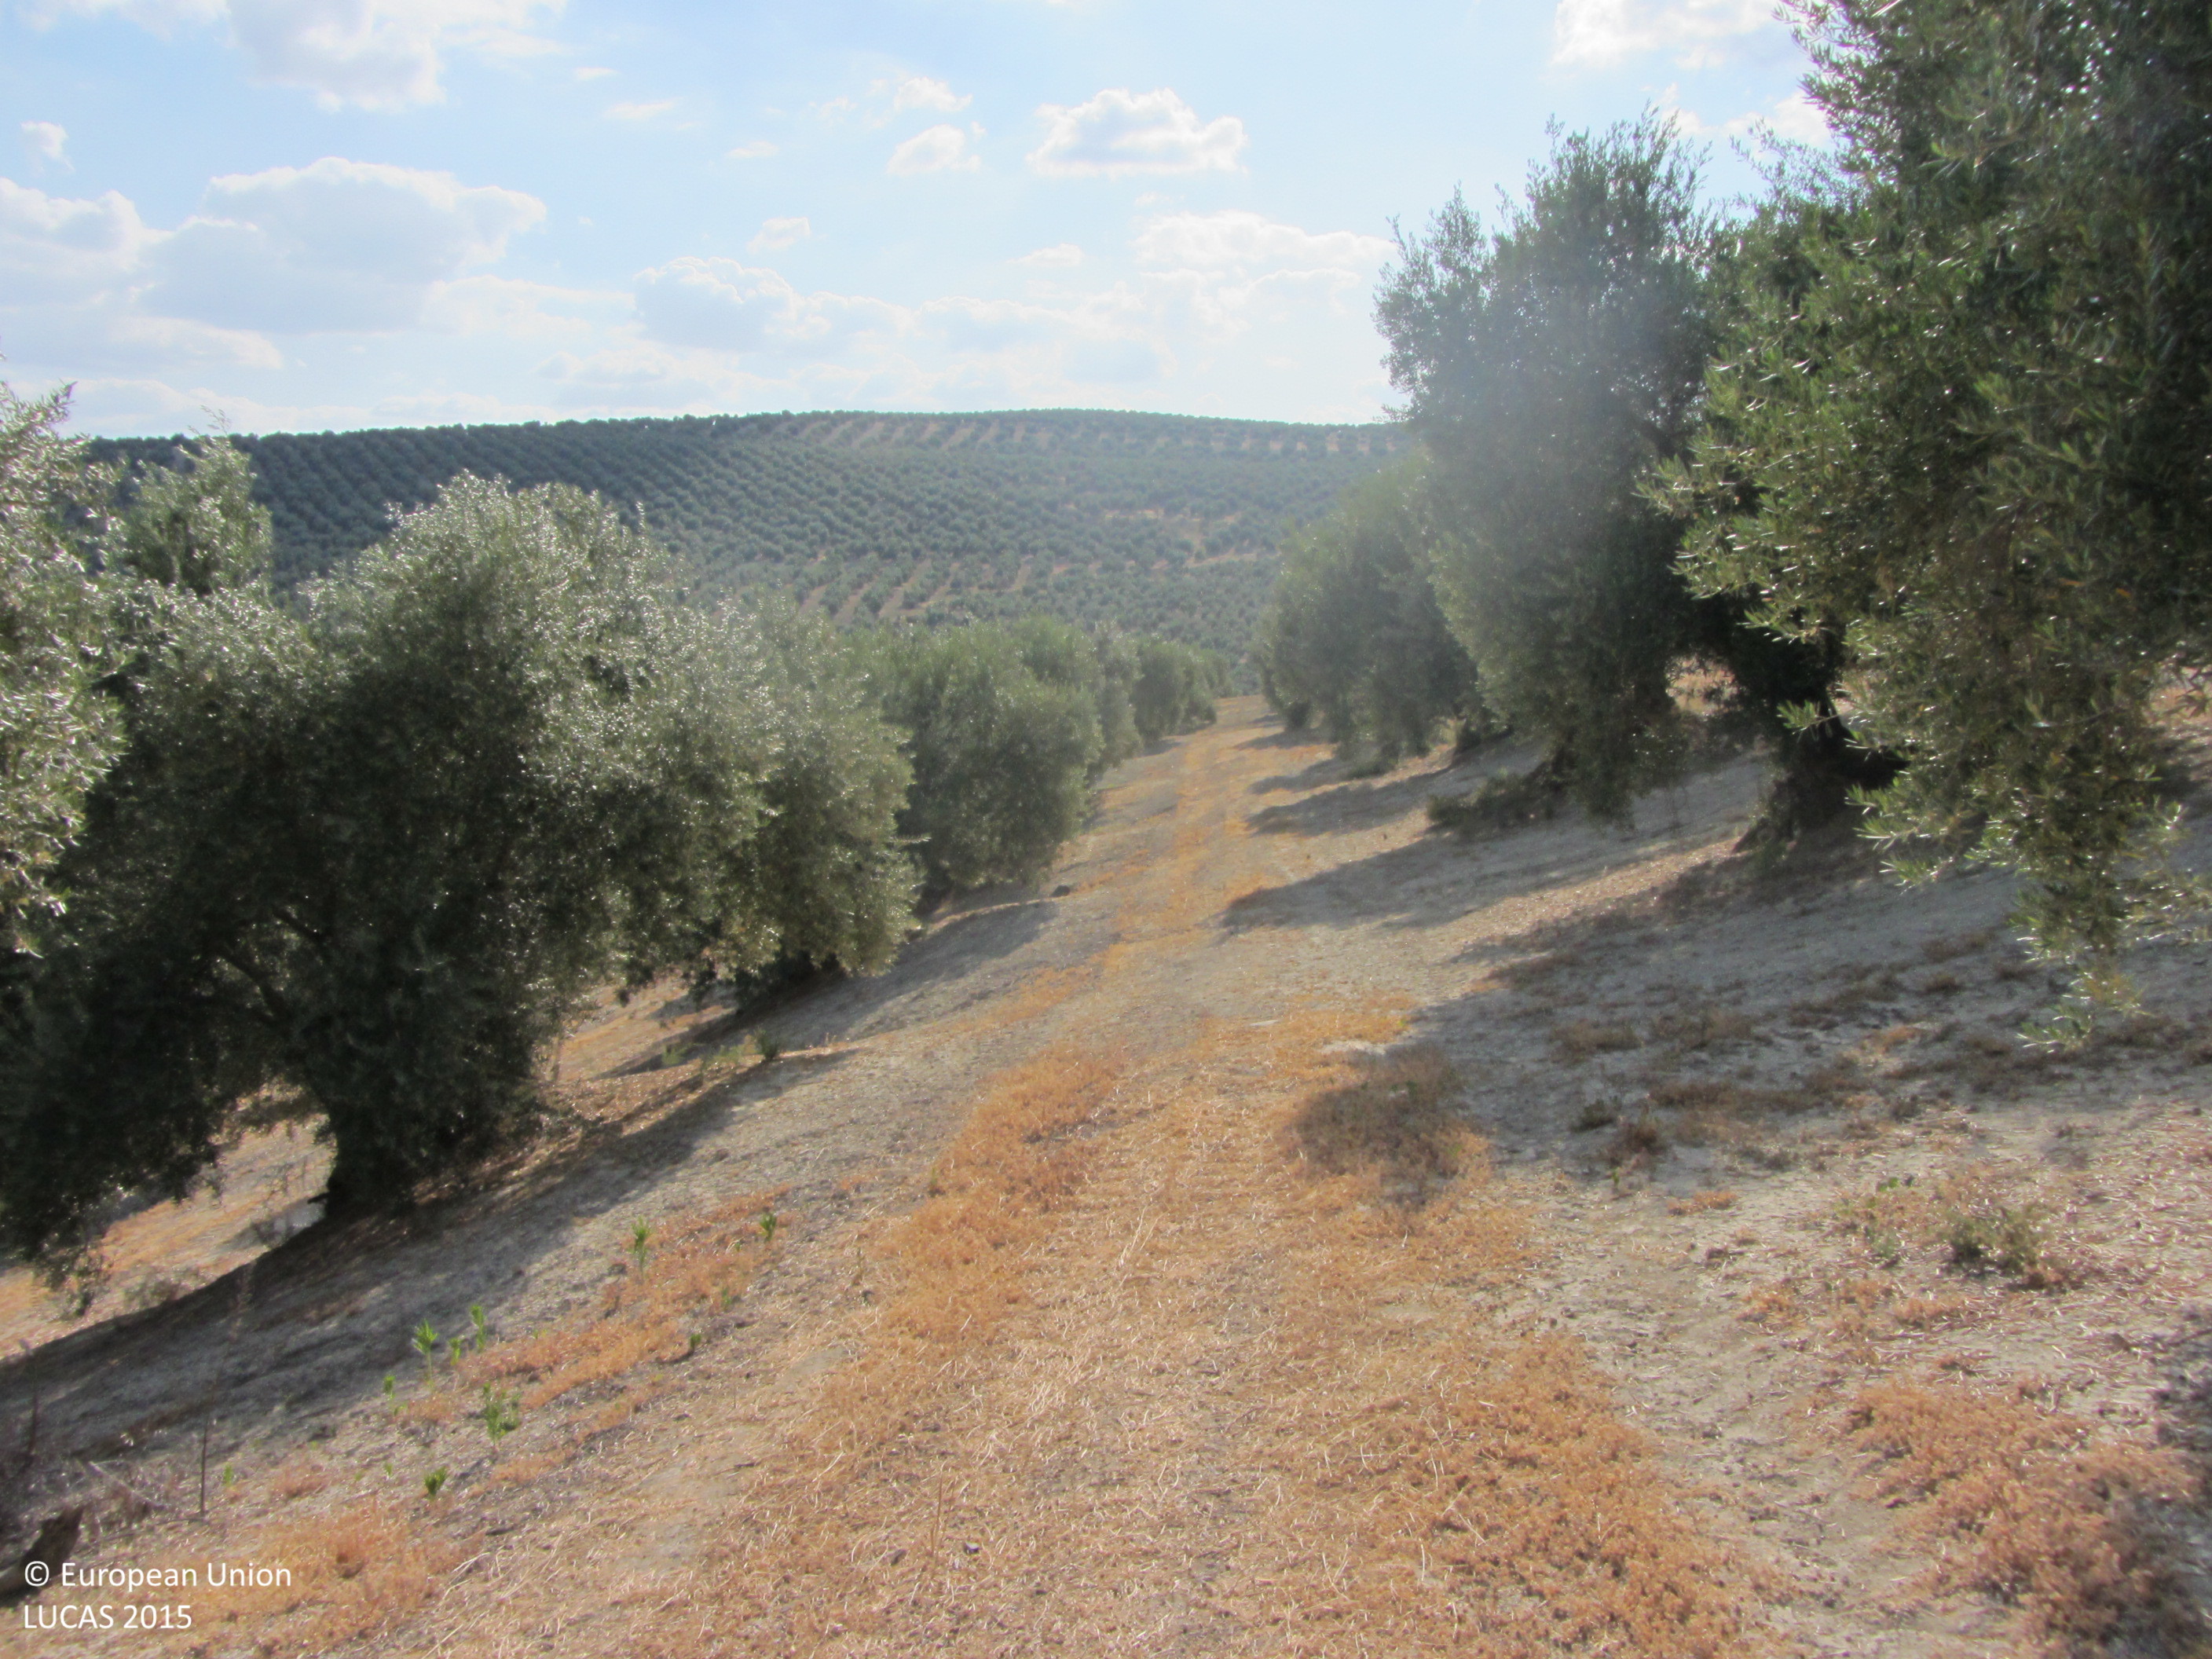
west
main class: Cropland
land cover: Olive groves
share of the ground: 50 - 75 %
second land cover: Other bare soil
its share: > 75 %
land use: Agriculture (excluding fallow land and kitchen gardens)
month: June
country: ES
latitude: 37.9703
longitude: -3.2599
